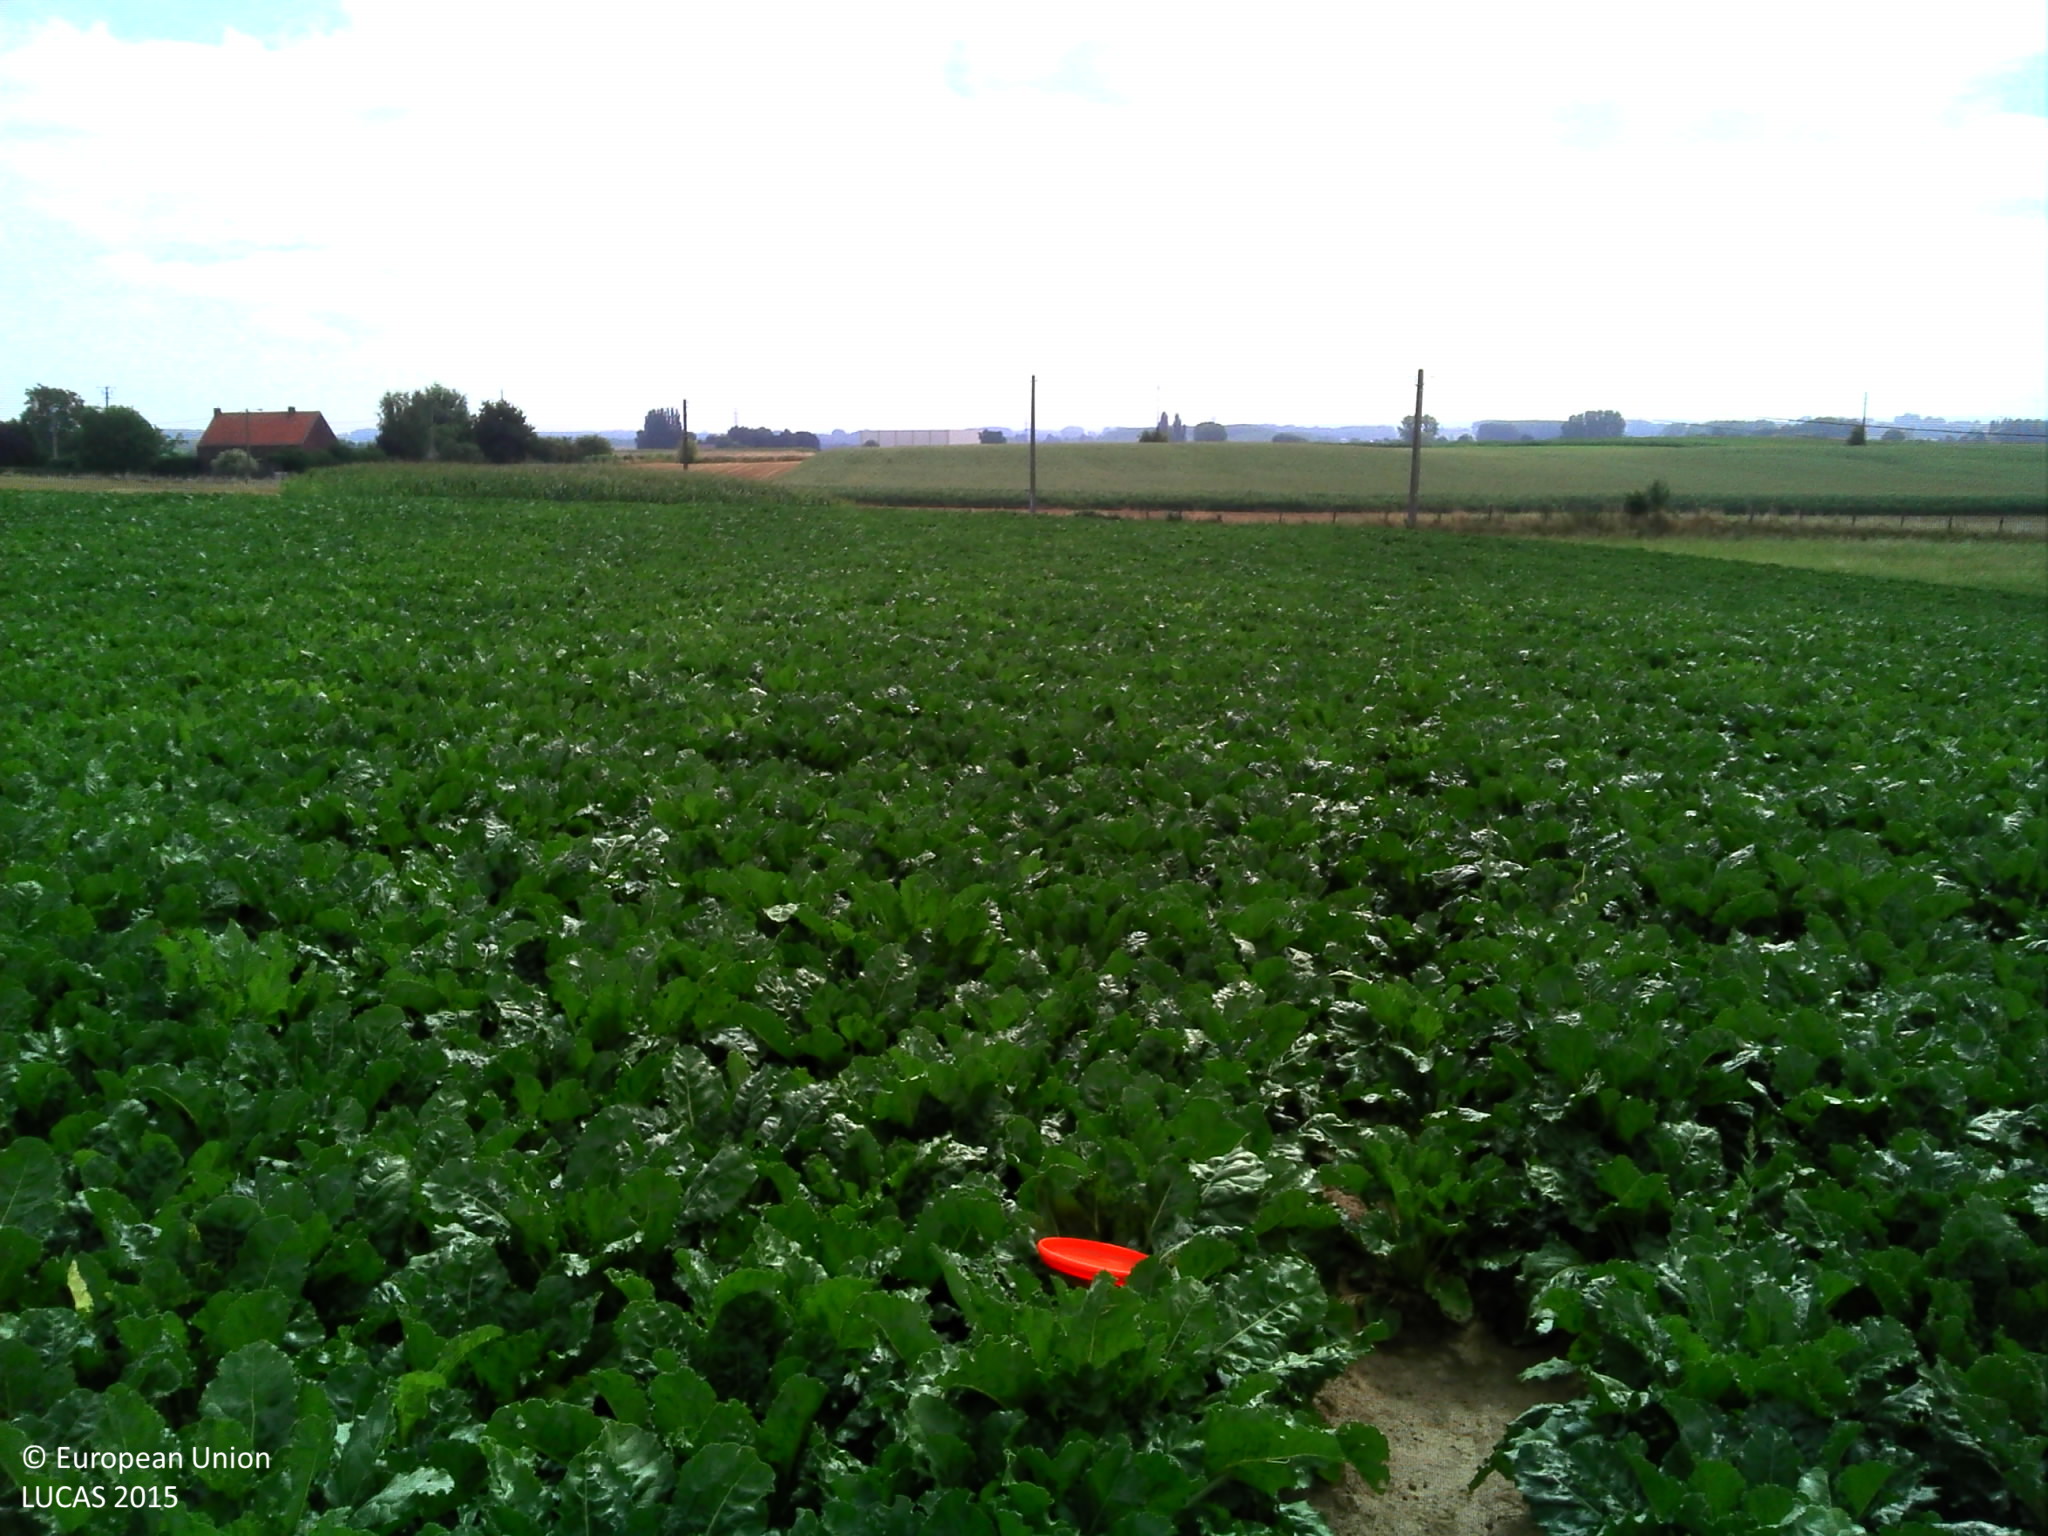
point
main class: Cropland
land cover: Sugar beet
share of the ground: > 75 %
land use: Agriculture (excluding fallow land and kitchen gardens)
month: August
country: BE
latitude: 50.7012
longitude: 3.8061
